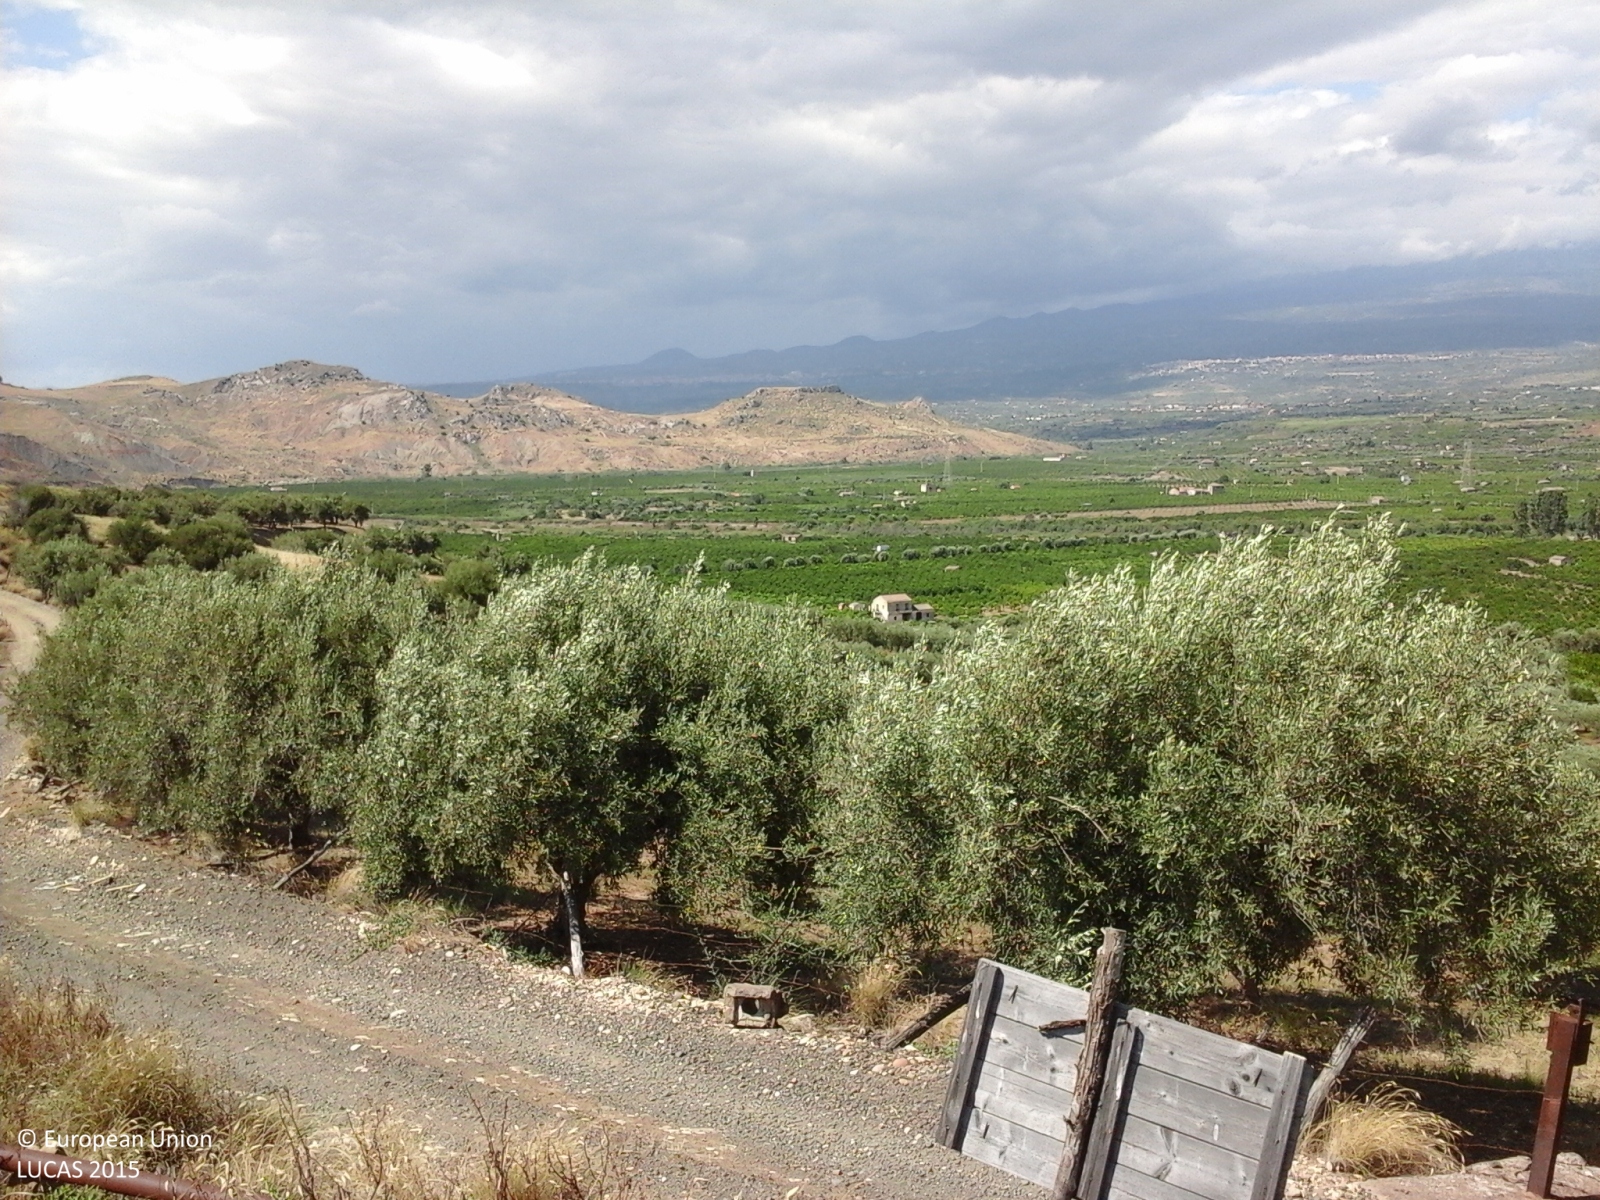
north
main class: Grassland
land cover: Grassland without tree/shrub cover
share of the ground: > 75 %
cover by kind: herbaceous plants 95 %, shrubs 5 %
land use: Agriculture (excluding fallow land and kitchen gardens)
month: June
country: IT
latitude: 37.5513
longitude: 14.8438
